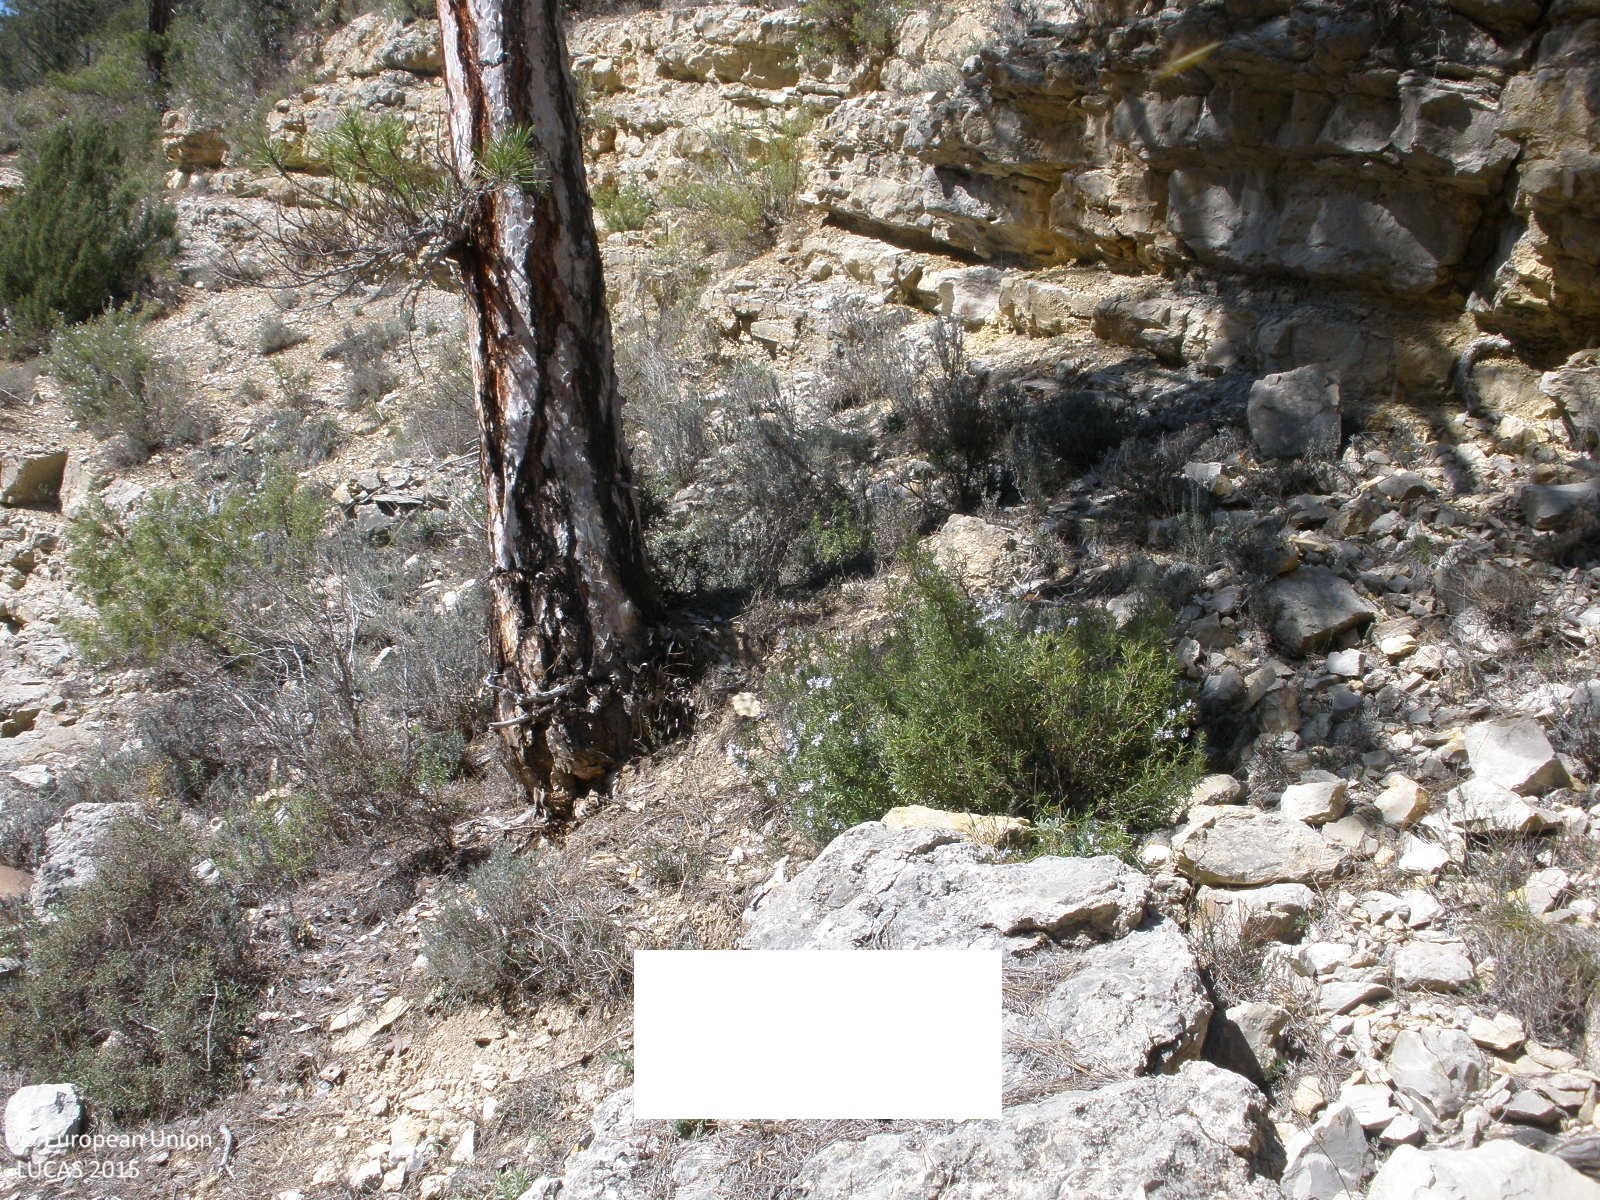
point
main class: Woodland
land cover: Pine dominated coniferous woodland
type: coniferous forest of the mediterranean region
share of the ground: 25 - 50 %
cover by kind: coniferous forest trees 40 %, shrubs 40 %, consolidated bare surface 20 %
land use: Semi-natural and natural areas not in use
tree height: > 5 m
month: April
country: ES
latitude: 40.2760
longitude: -1.2424
